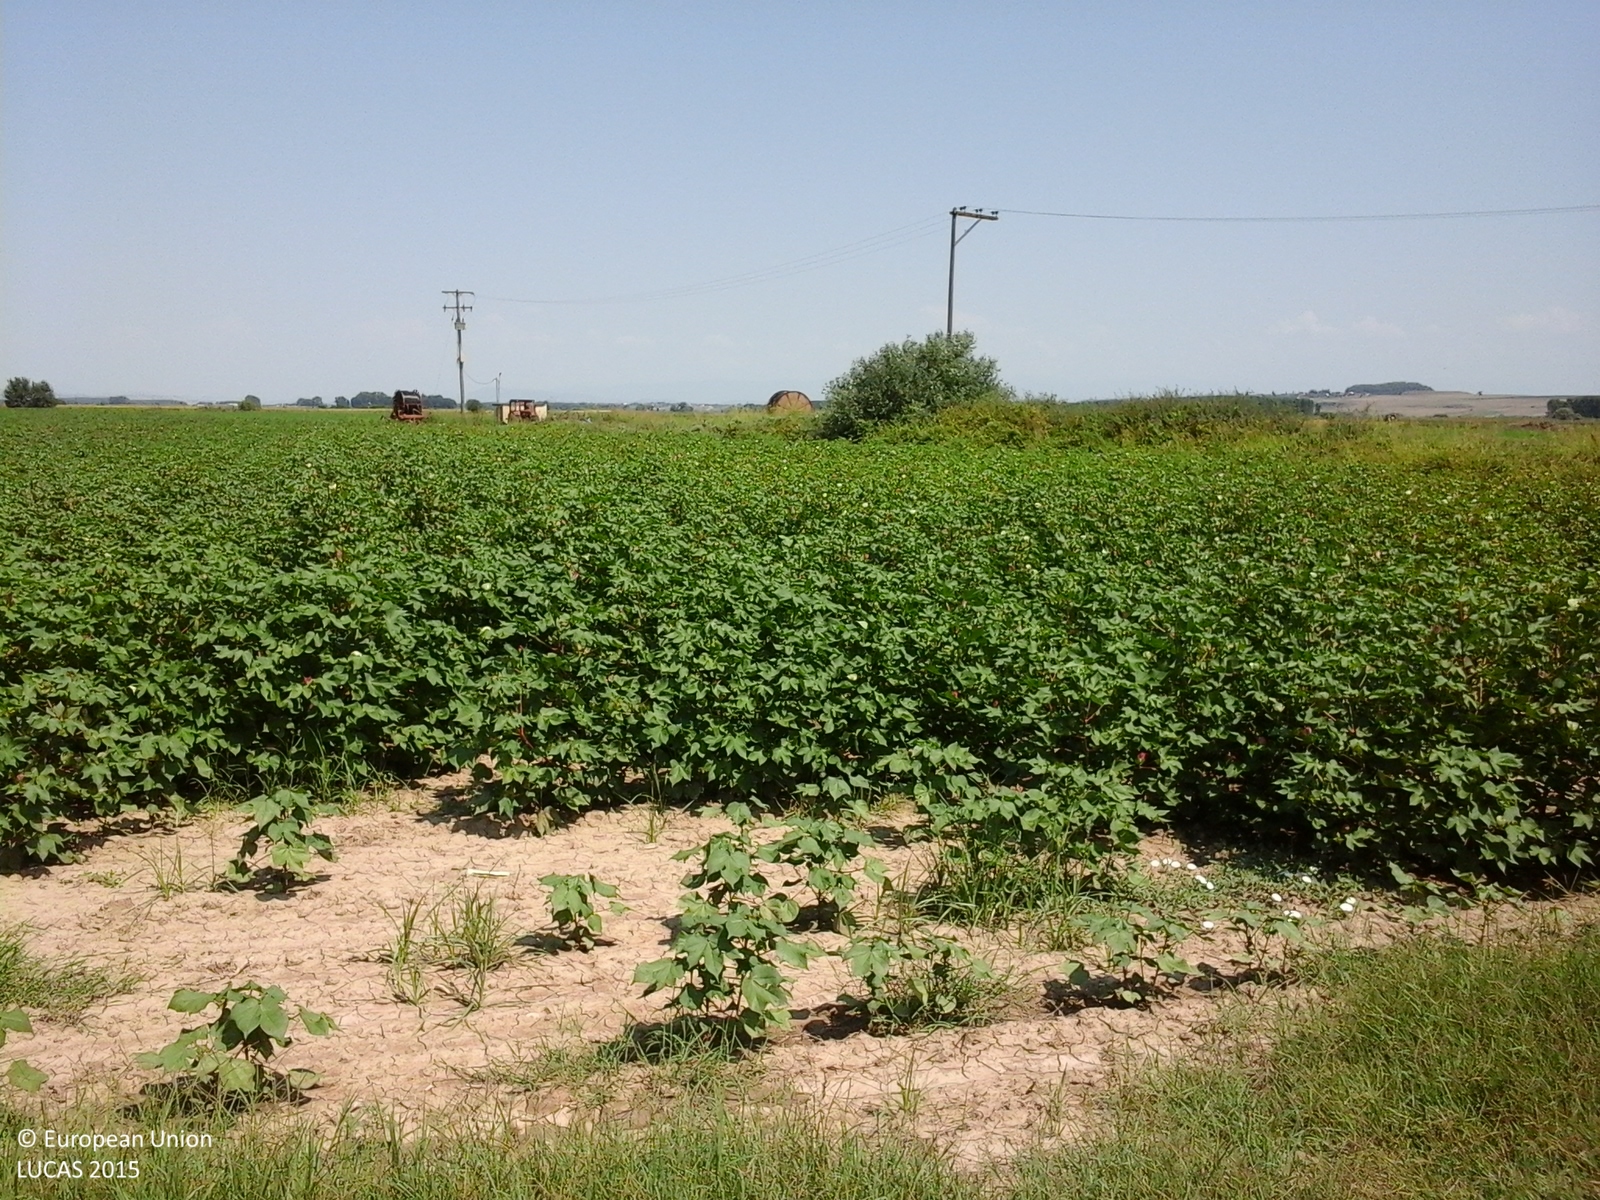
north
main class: Cropland
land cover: Maize
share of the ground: > 75 %
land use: Agriculture (excluding fallow land and kitchen gardens)
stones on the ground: < 10 %
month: August
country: GR
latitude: 40.8393
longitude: 22.6126
